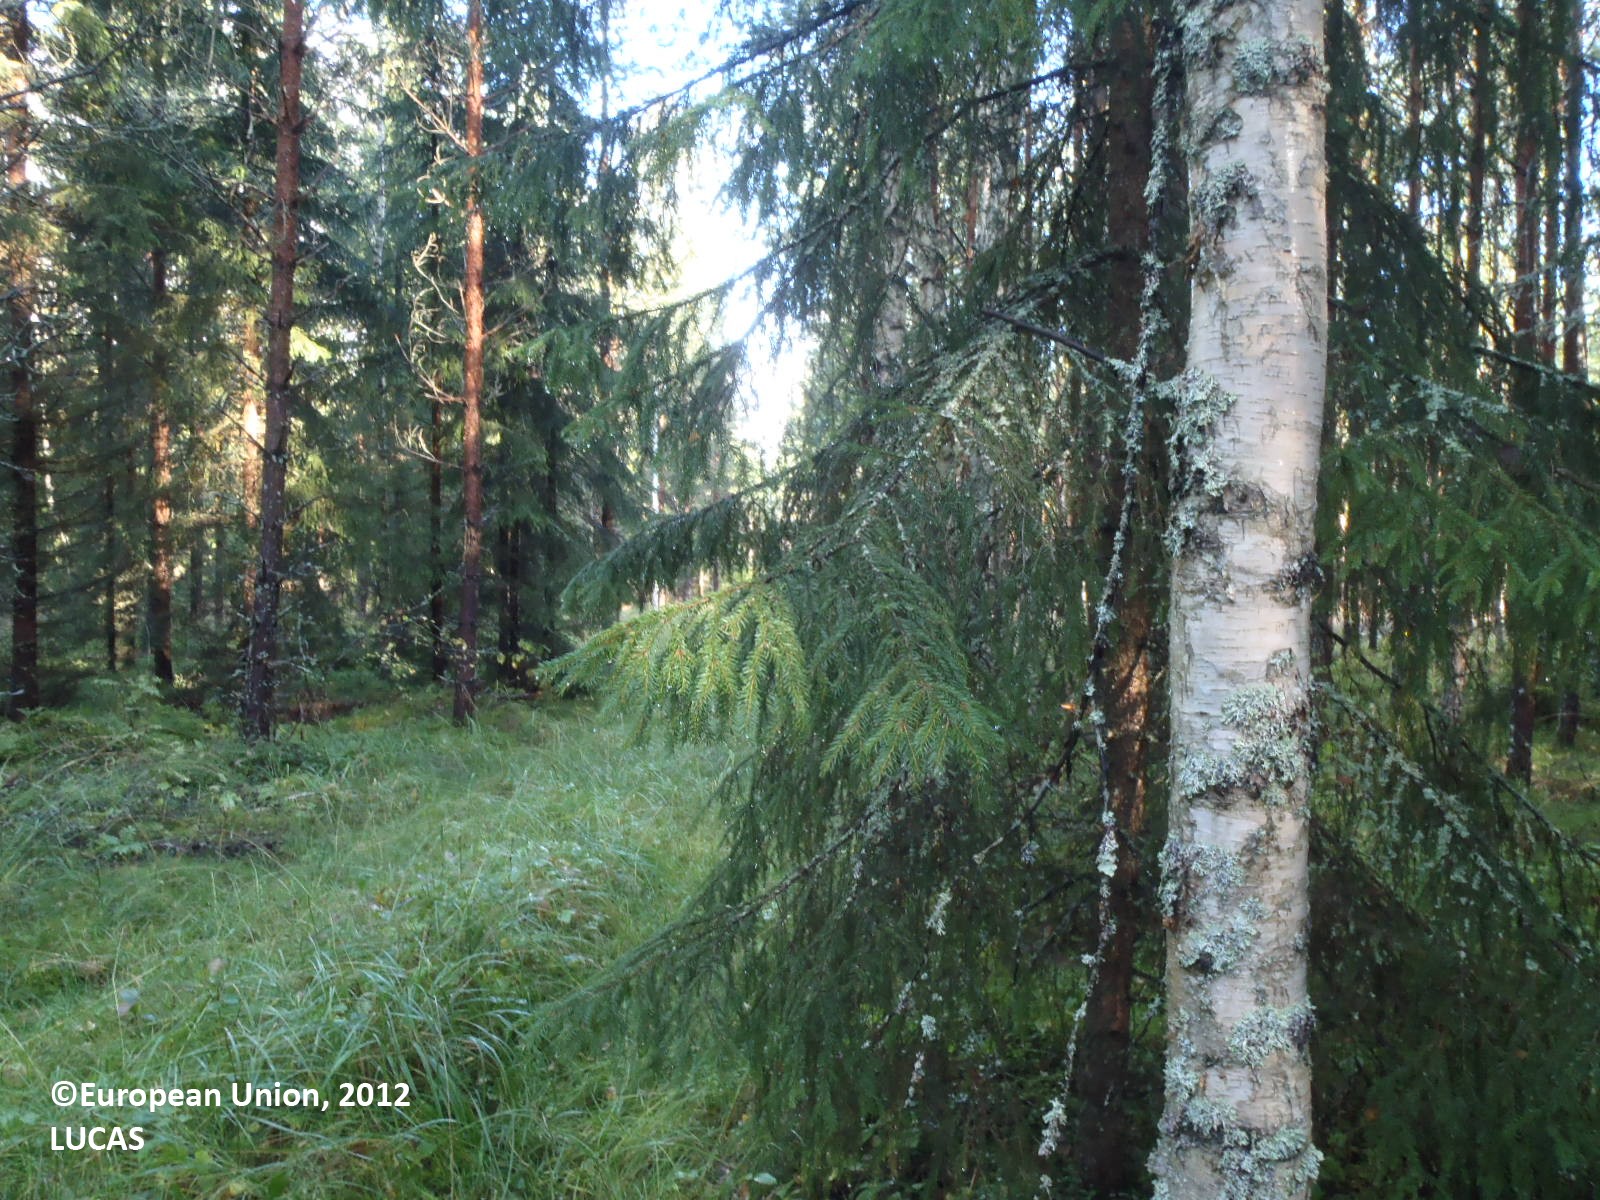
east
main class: Woodland
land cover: Pine dominated mixed woodland
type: boreal forest
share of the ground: > 75 %
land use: Forestry
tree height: > 5 m
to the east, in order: Pine dominated mixed woodland; Ditches and canals; Pine dominated mixed woodland
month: September
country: FI
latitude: 61.0909
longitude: 22.6223
